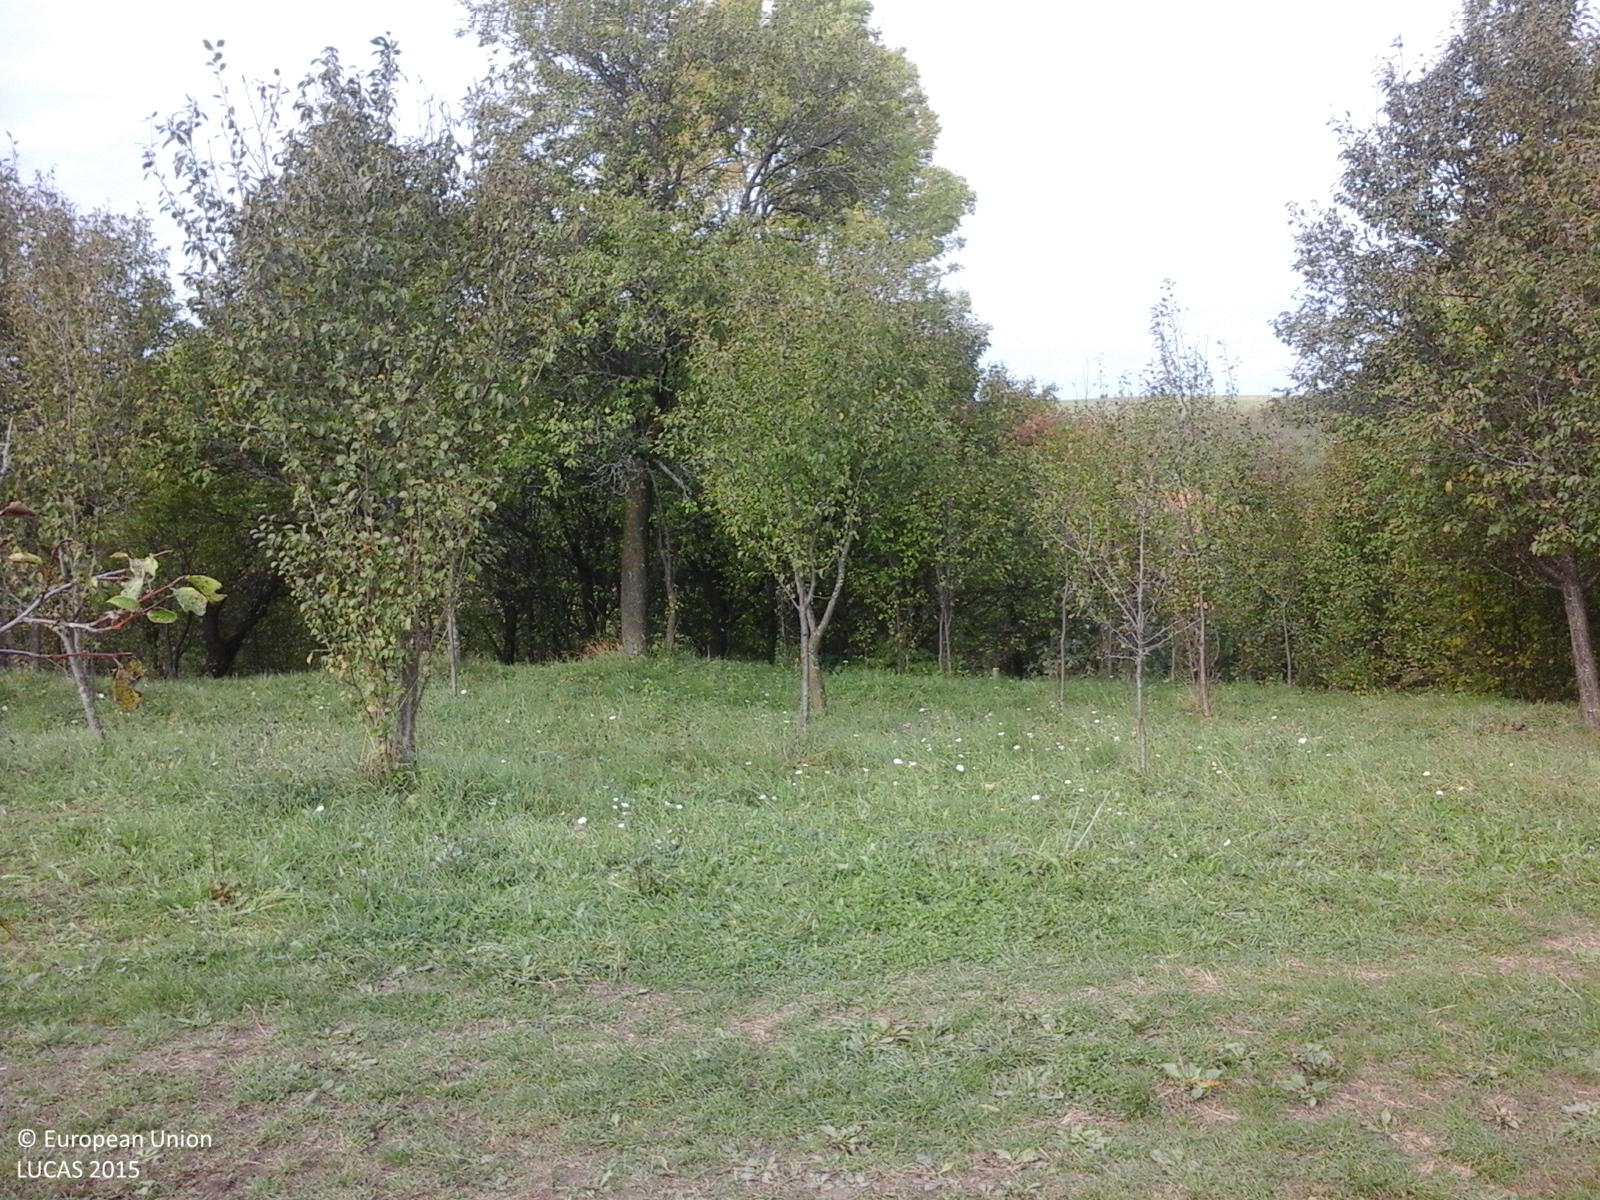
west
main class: Grassland
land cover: Grassland without tree/shrub cover
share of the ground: > 75 %
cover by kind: herbaceous plants 100 %
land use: Agriculture (excluding fallow land and kitchen gardens)
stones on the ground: < 10 %
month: October
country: RO
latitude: 46.3741
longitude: 25.3272
